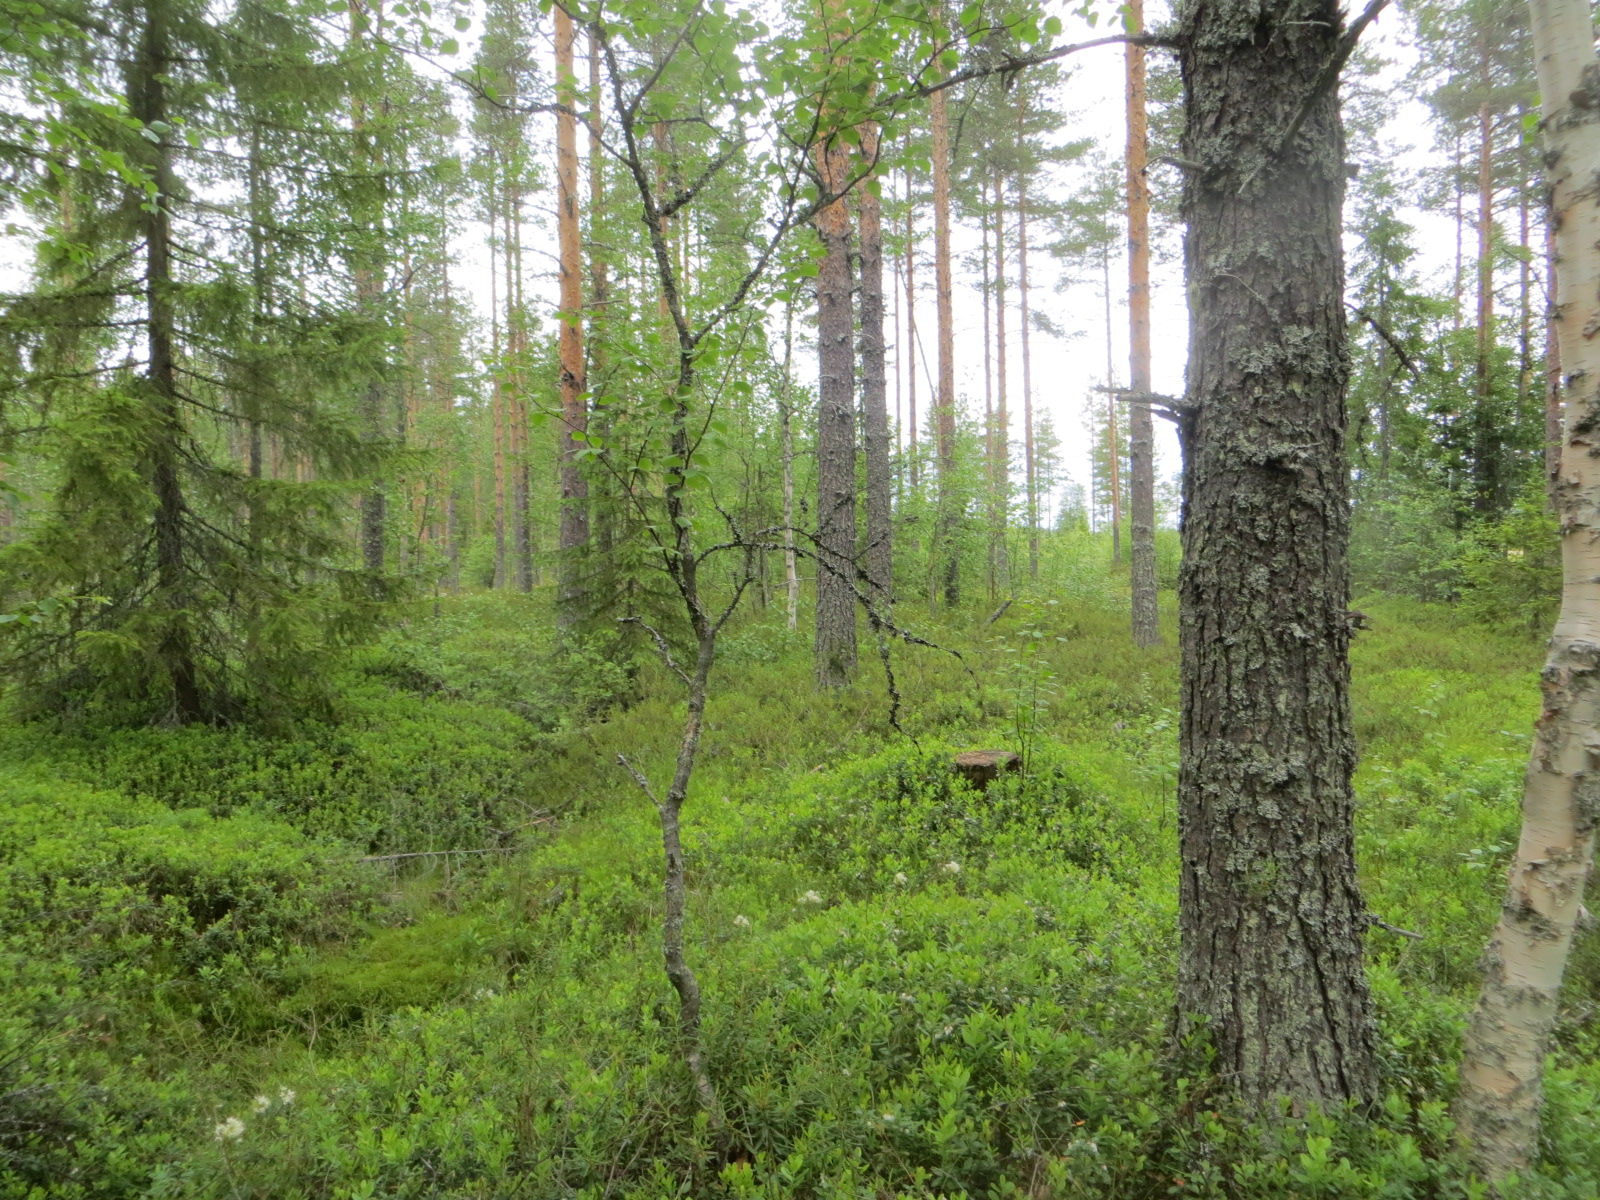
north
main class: Woodland
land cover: Pine dominated mixed woodland
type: boreal forest
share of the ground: 50 - 75 %
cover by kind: coniferous forest trees 50 %, shrubs 30 %, broadleaved forest trees 20 %
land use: Forestry
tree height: > 5 m
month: July
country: FI
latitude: 65.4726
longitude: 25.9559
